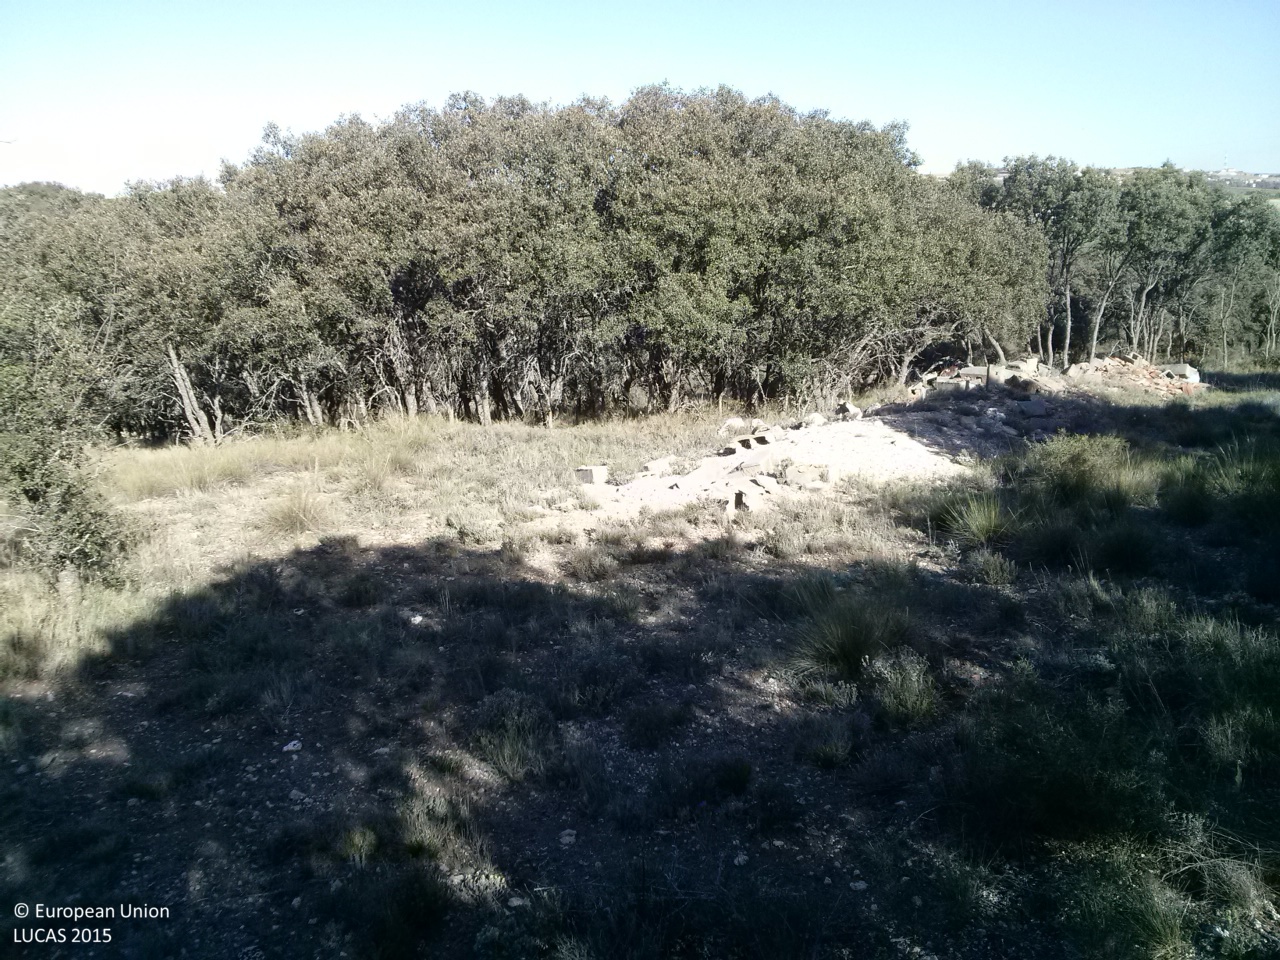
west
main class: Woodland
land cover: Broadleaved woodland
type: broadleaved evergreen forest
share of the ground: 25 - 50 %
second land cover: Grassland without tree/shrub cover
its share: 25 - 50 %
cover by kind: broadleaved forest trees 45 %, herbaceous plants 30 %, unconsolidated bare surface 20 %, shrubs 5 %
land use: Forestry
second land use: Agriculture (excluding fallow land and kitchen gardens)
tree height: < 5 m
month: May
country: ES
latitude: 39.9033
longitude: -2.7812
